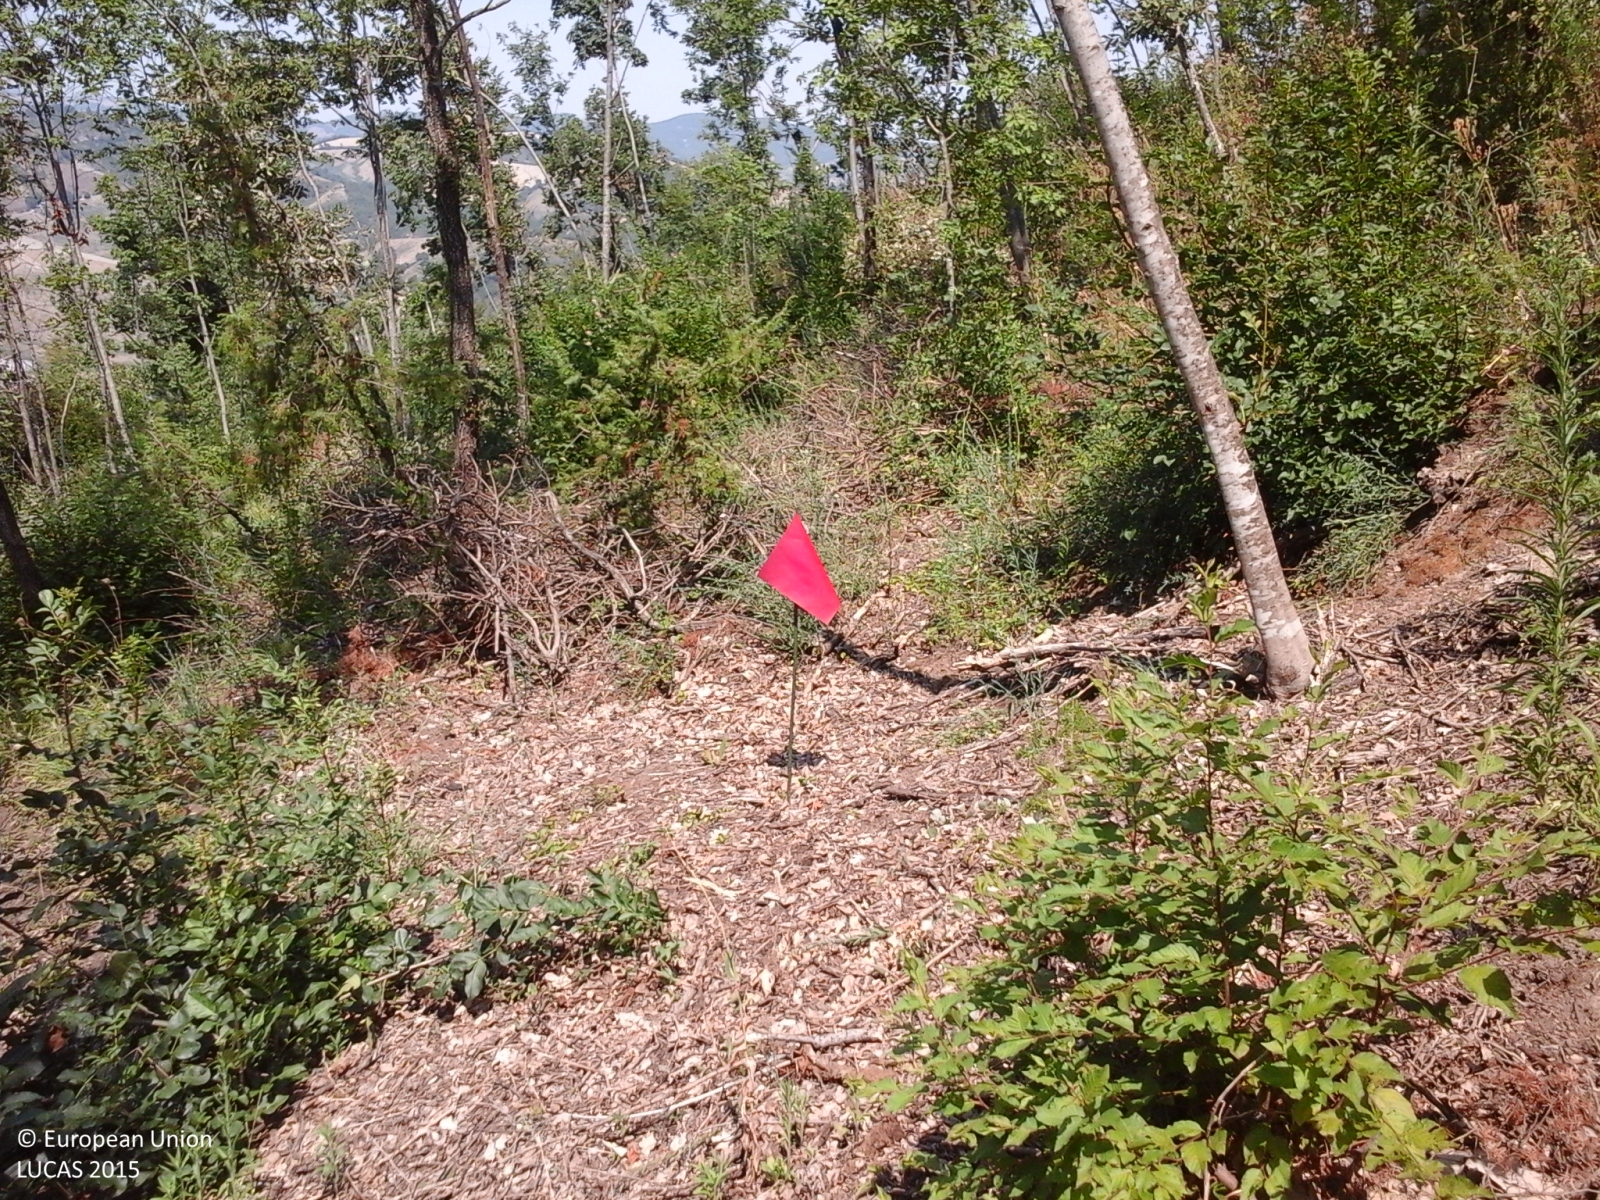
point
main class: Woodland
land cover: Broadleaved woodland
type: thermophilous deciduous forest
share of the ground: > 75 %
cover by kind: broadleaved forest trees 100 %
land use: Forestry
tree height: > 5 m
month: August
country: IT
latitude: 43.7094
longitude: 12.3892
